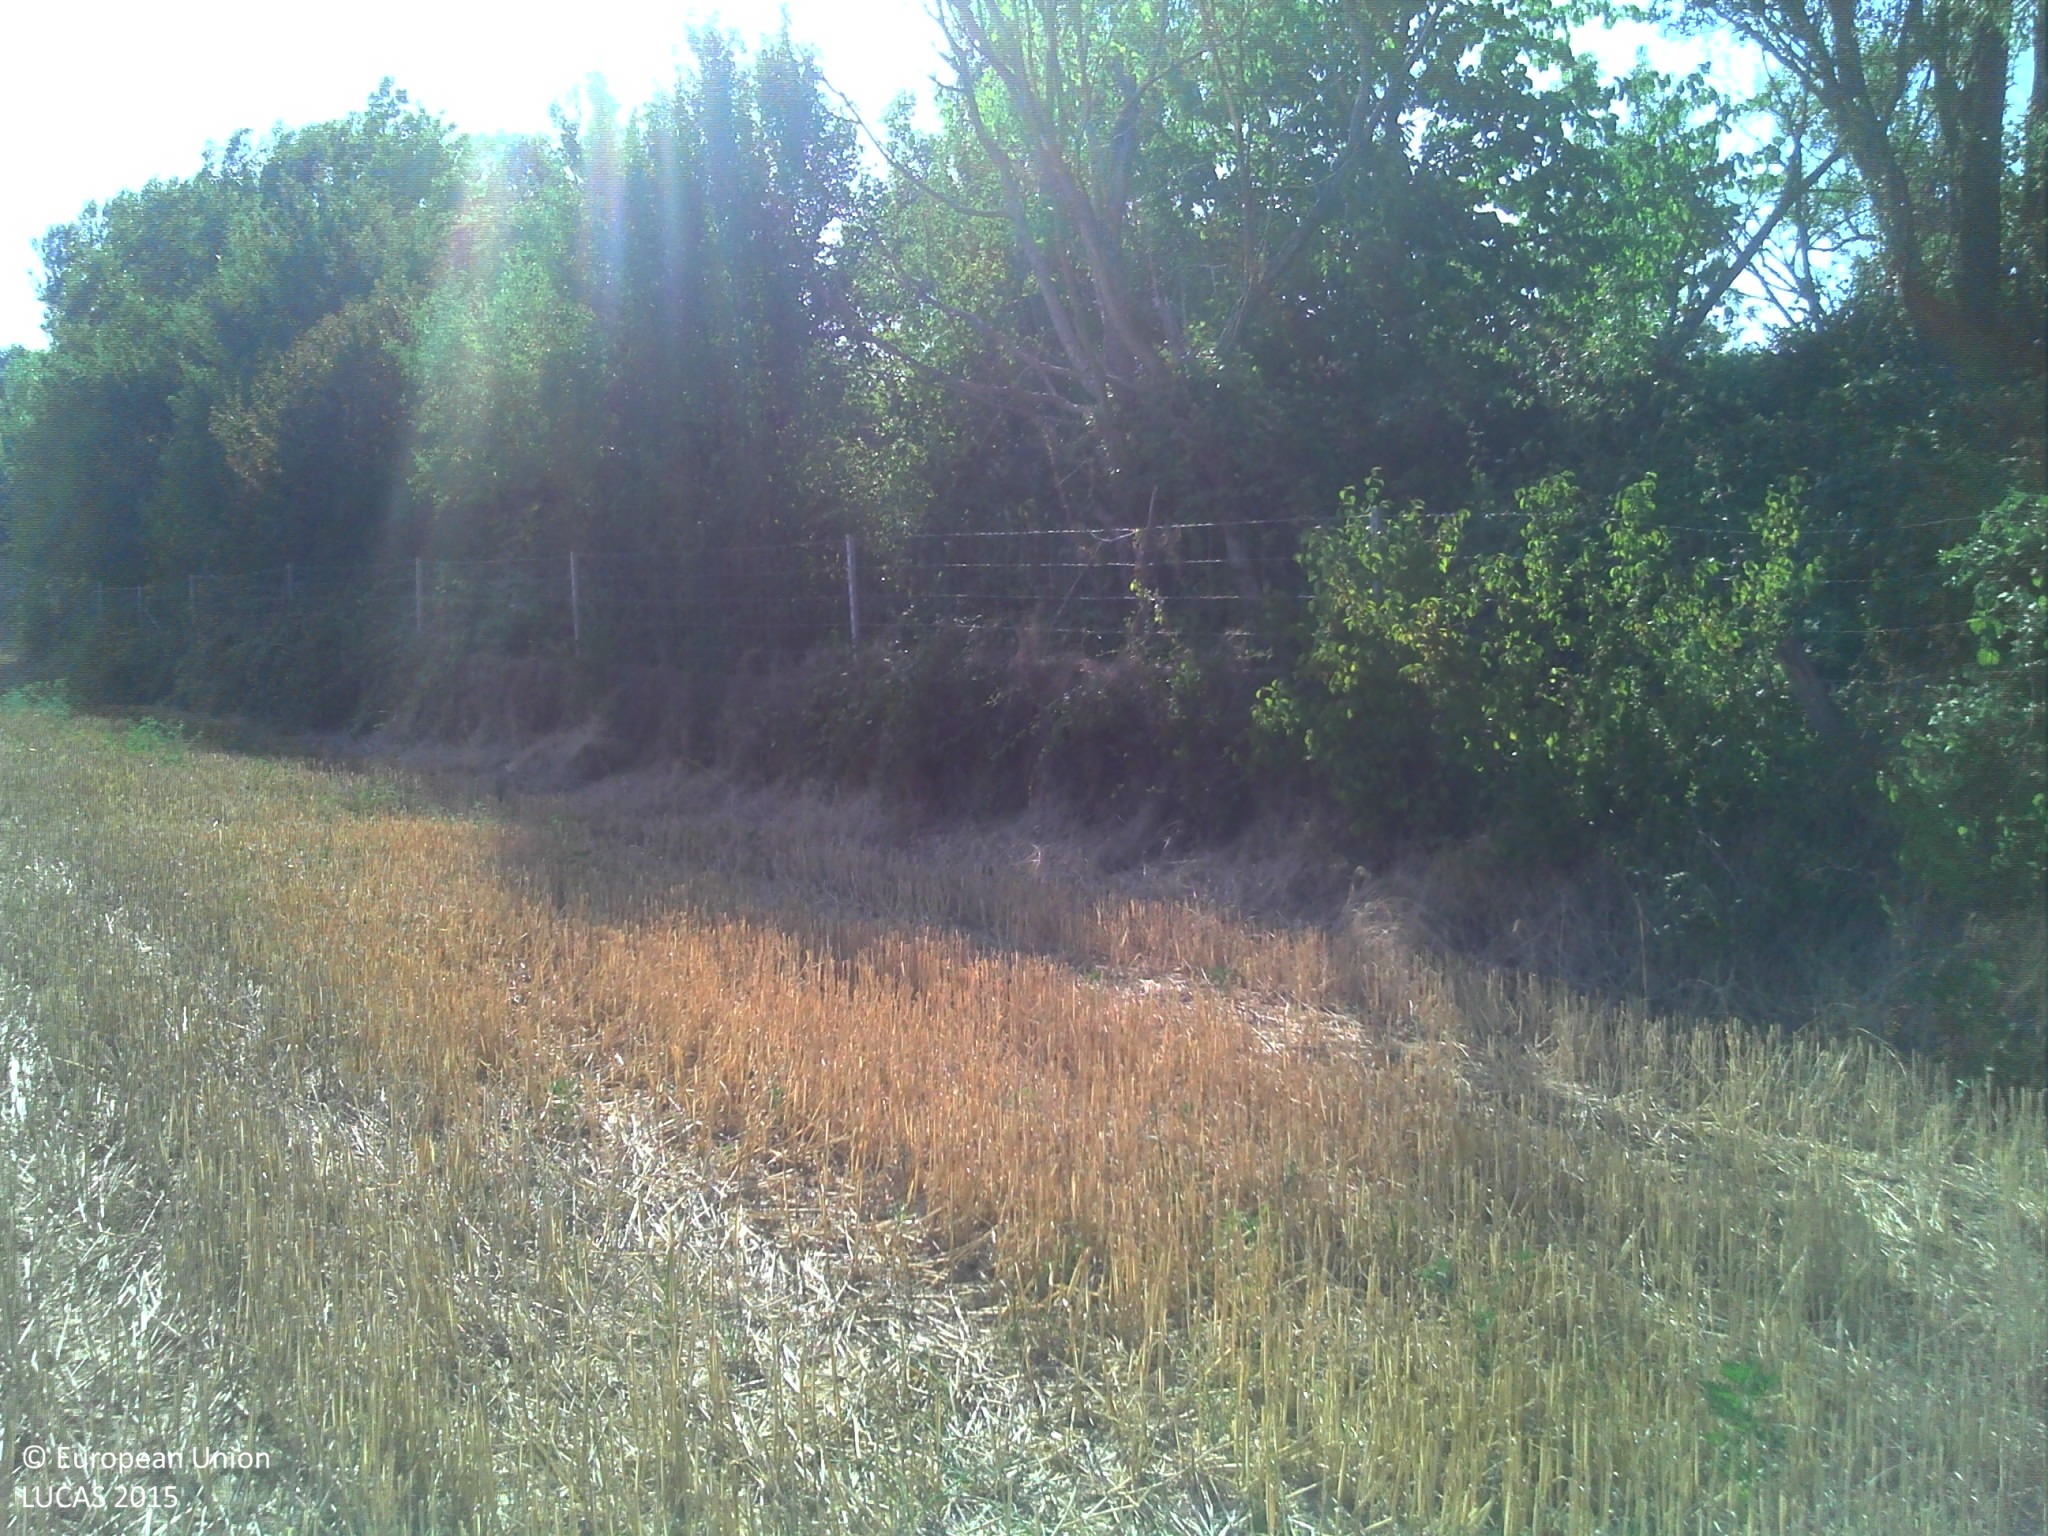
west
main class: Cropland
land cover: Durum wheat
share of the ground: 10 - 25 %
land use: Agriculture (excluding fallow land and kitchen gardens)
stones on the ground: 25 - 50 %
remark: Harvested field
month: August
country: FR
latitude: 45.6153
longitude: 4.8873
